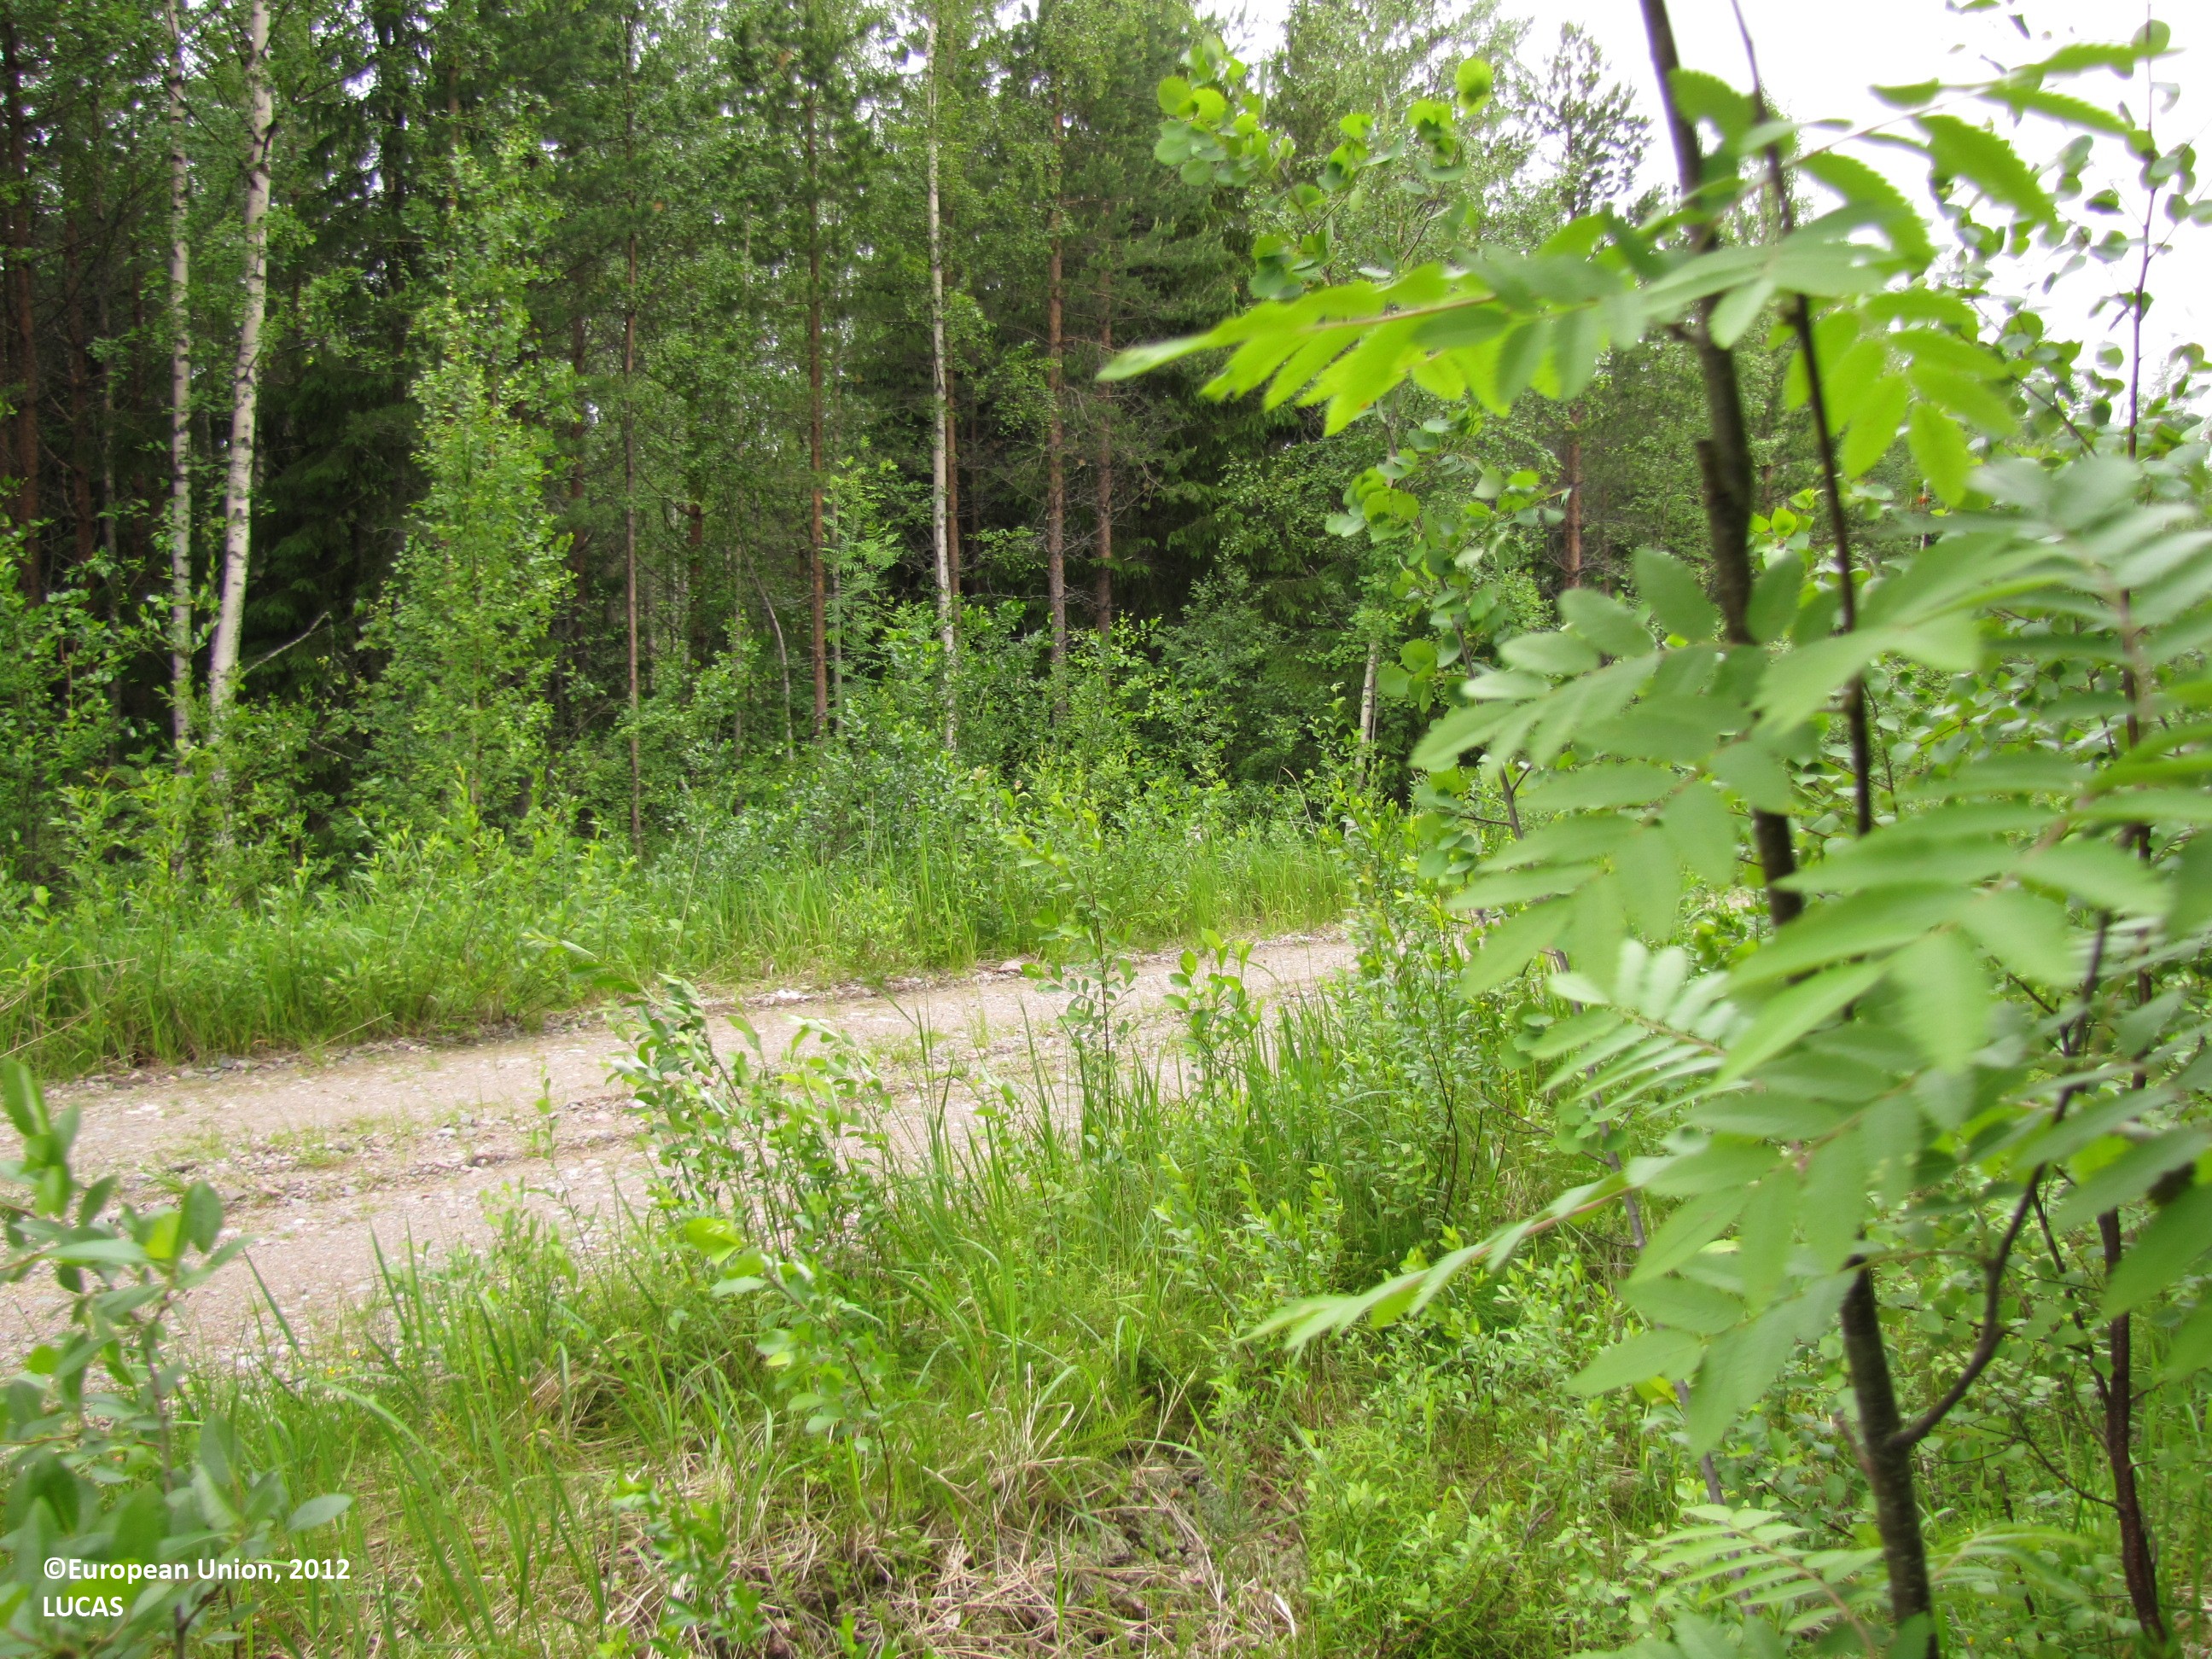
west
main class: Woodland
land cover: Pine dominated mixed woodland
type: boreal forest
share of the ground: 25 - 50 %
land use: Forestry
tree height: > 5 m
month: June
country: FI
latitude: 61.8058
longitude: 24.5740
